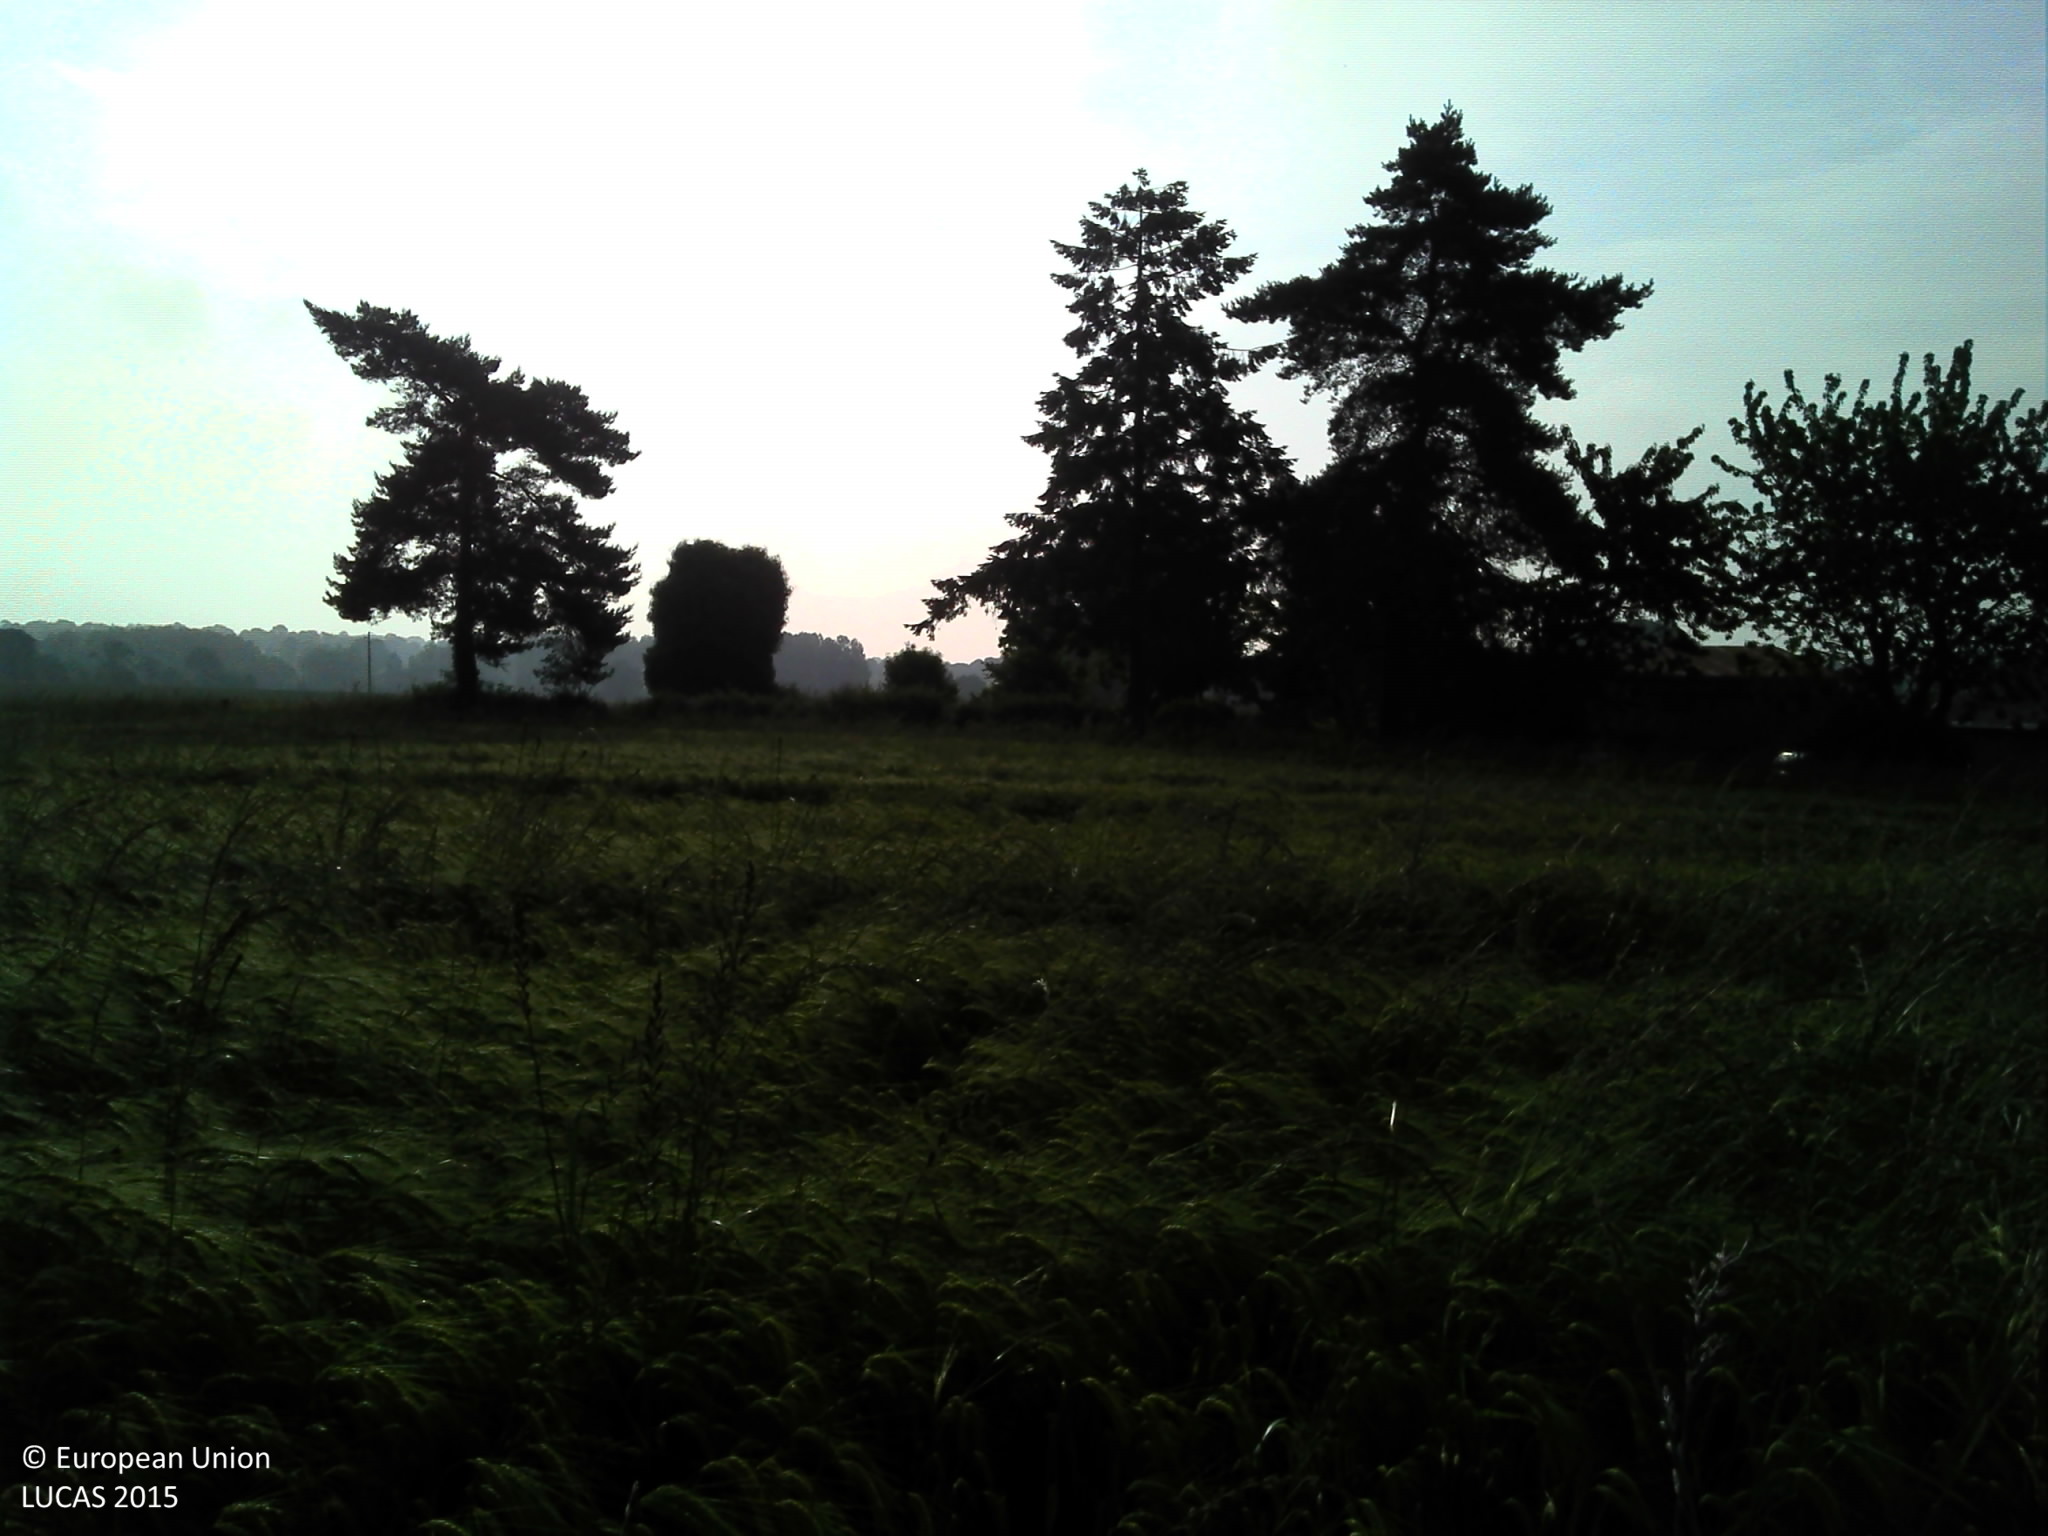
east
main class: Cropland
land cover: Barley
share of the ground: > 75 %
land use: Agriculture (excluding fallow land and kitchen gardens)
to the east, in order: Barley; Grass margins; Ditches and canals; Grass margins; Paved roads, cycling and walking lanes; Grass margins; Lines of trees; Grassland without tree/shrub cover; Lines of trees; Common wheat; Grass margins; Tracks
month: June
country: FR
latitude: 48.4151
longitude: -1.7098
